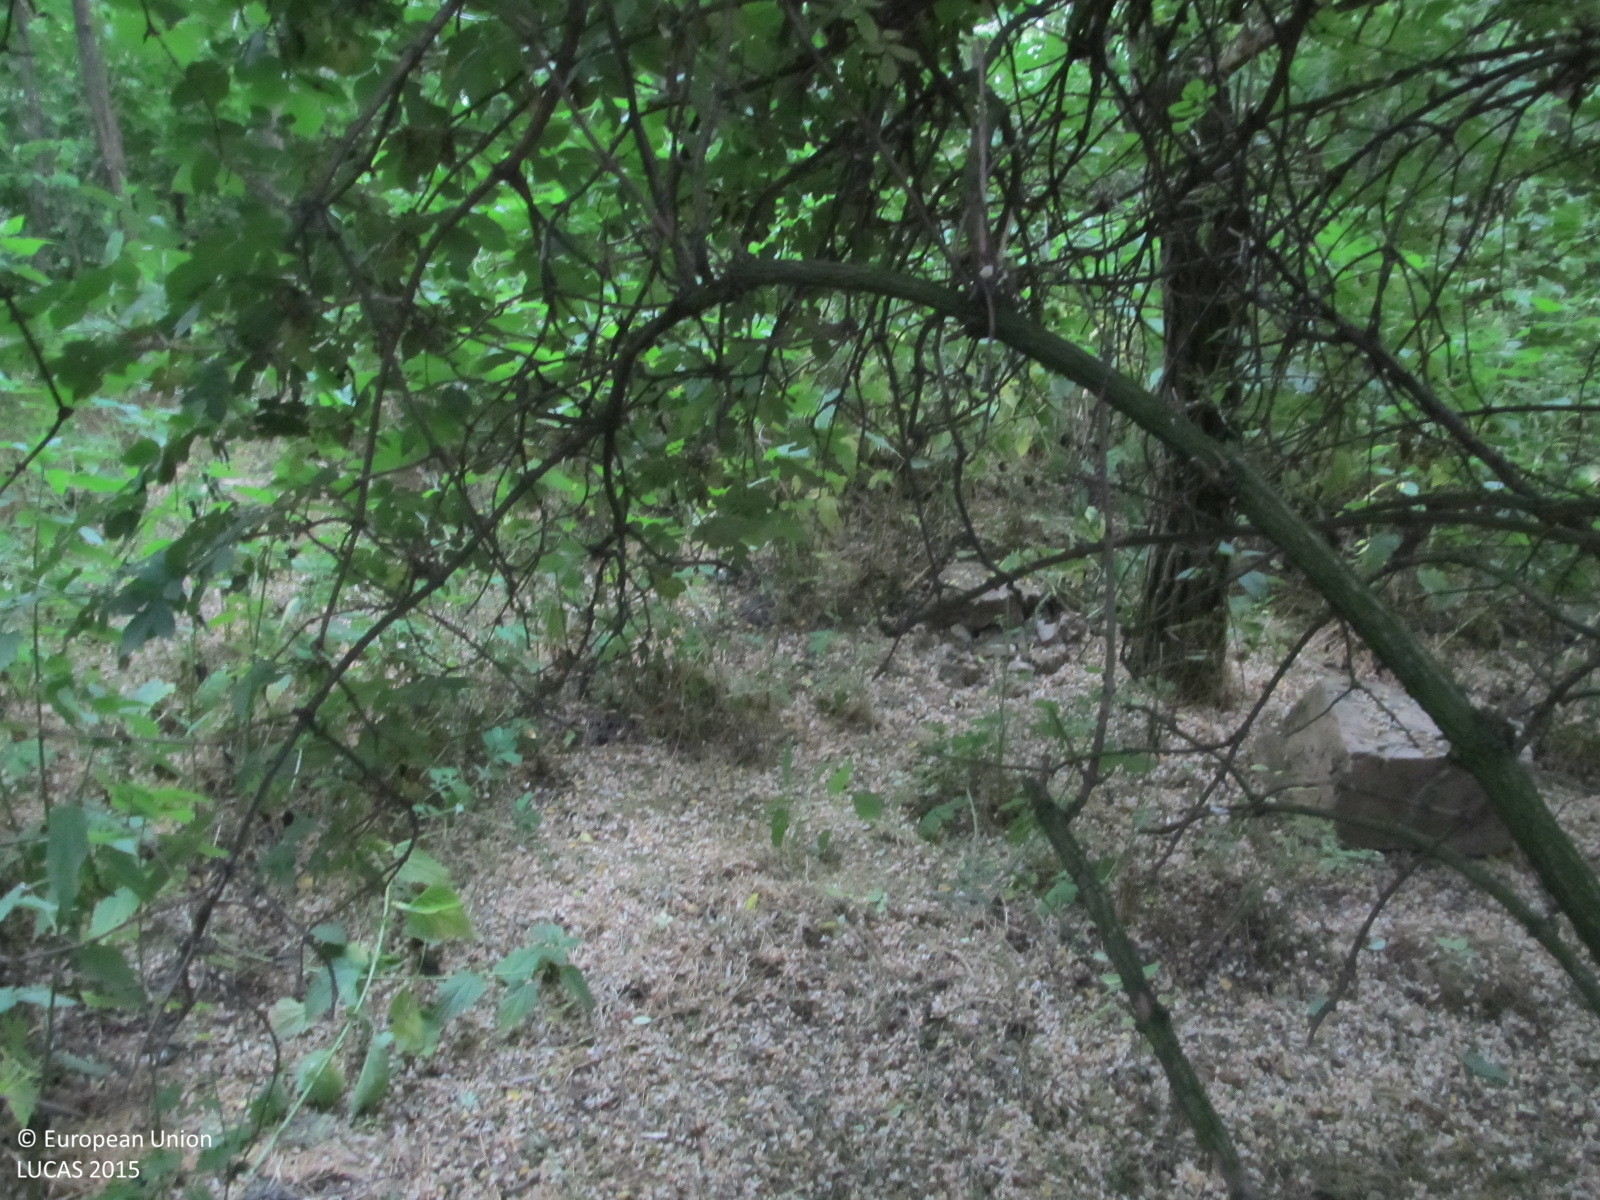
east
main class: Woodland
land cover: Broadleaved woodland
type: exotic forest
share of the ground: > 75 %
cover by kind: broadleaved forest trees 80 %, shrubs 10 %, herbaceous plants 10 %
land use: Semi-natural and natural areas not in use
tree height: > 5 m
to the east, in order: Broadleaved woodland; Grassland without tree/shrub cover; Abandoned hedges; Grassland without tree/shrub cover; Abandoned hedges; Grass margins; Maize
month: June
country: AT
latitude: 48.2659
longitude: 15.8637
